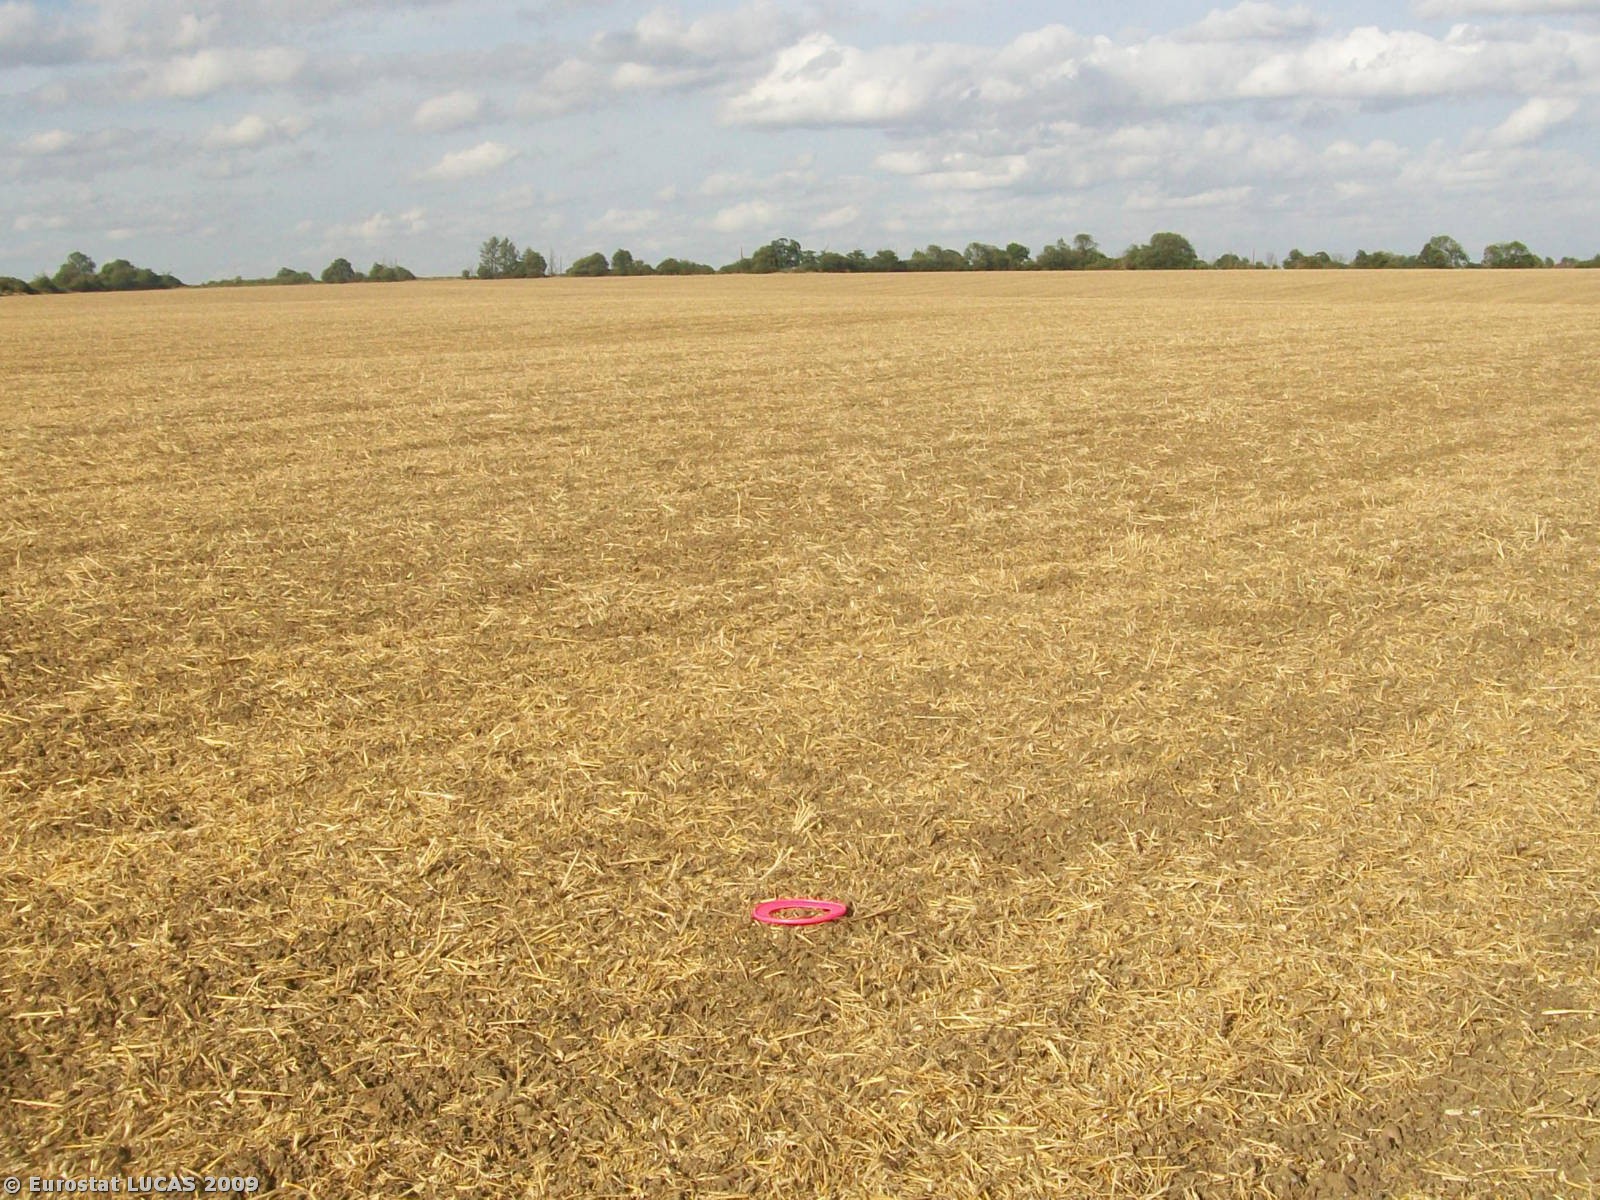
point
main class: Cropland
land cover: Common wheat
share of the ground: < 10 %
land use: Agriculture (excluding fallow land and kitchen gardens)
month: August
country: GB
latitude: 51.7279
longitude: 0.1088
